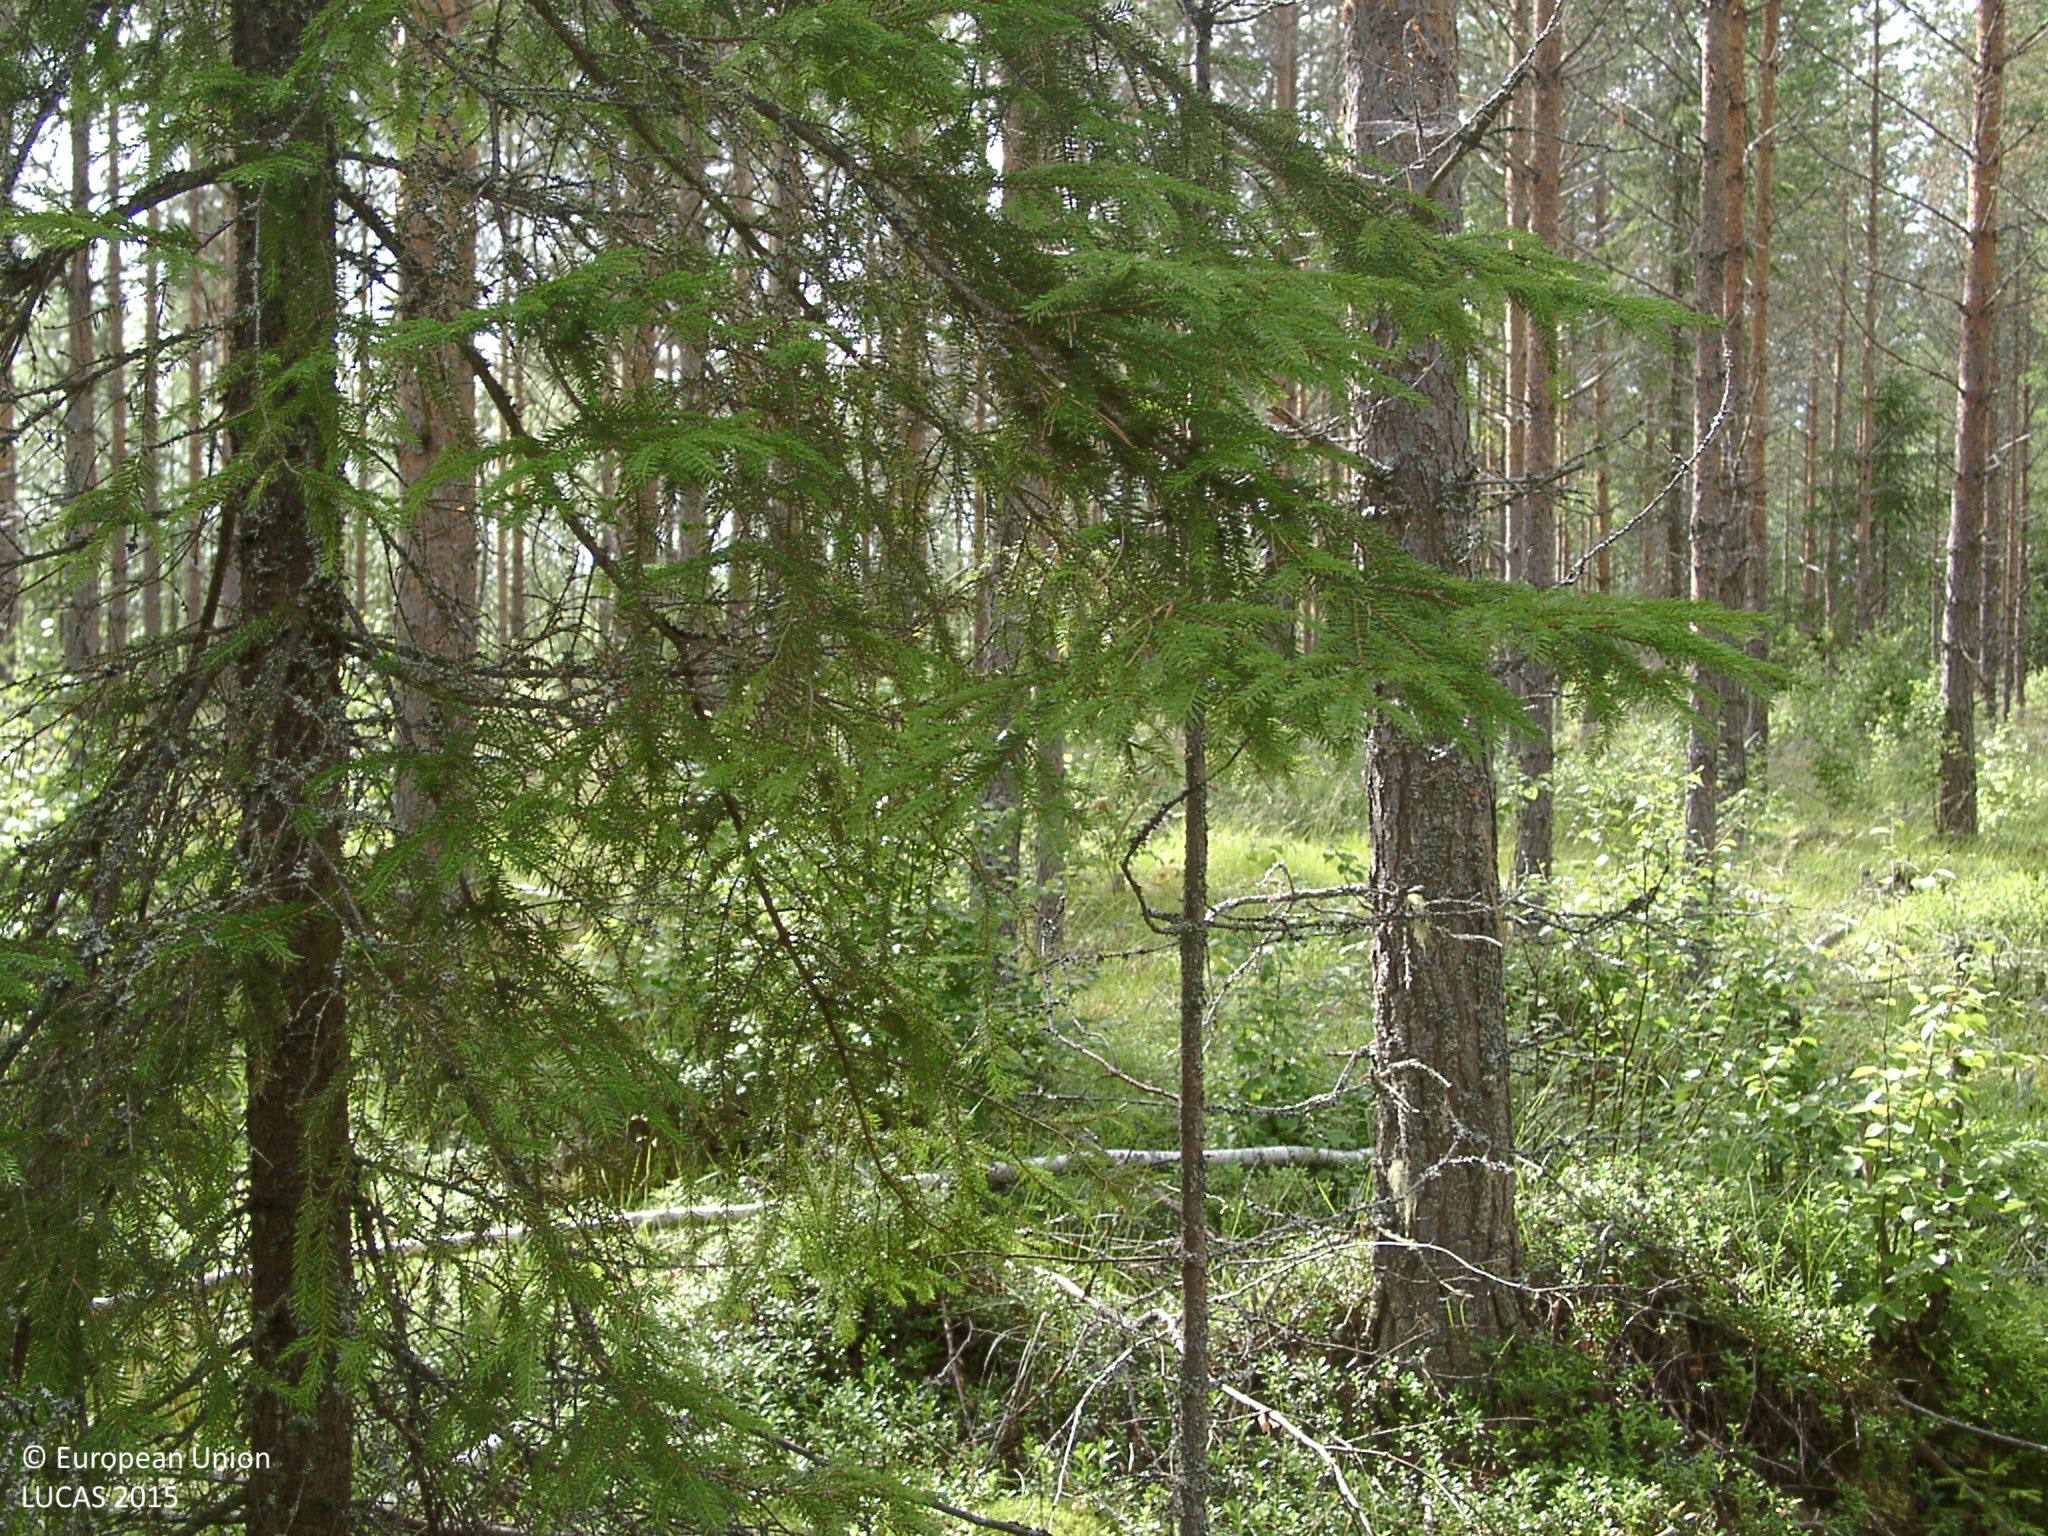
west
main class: Woodland
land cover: Pine dominated mixed woodland
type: boreal forest
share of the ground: 50 - 75 %
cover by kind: coniferous forest trees 45 %, broadleaved forest trees 15 %, shrubs 15 %, herbaceous plants 10 %, lichens and mosses 10 %
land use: Forestry
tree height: > 5 m
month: July
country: FI
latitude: 62.1678
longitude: 25.1790
